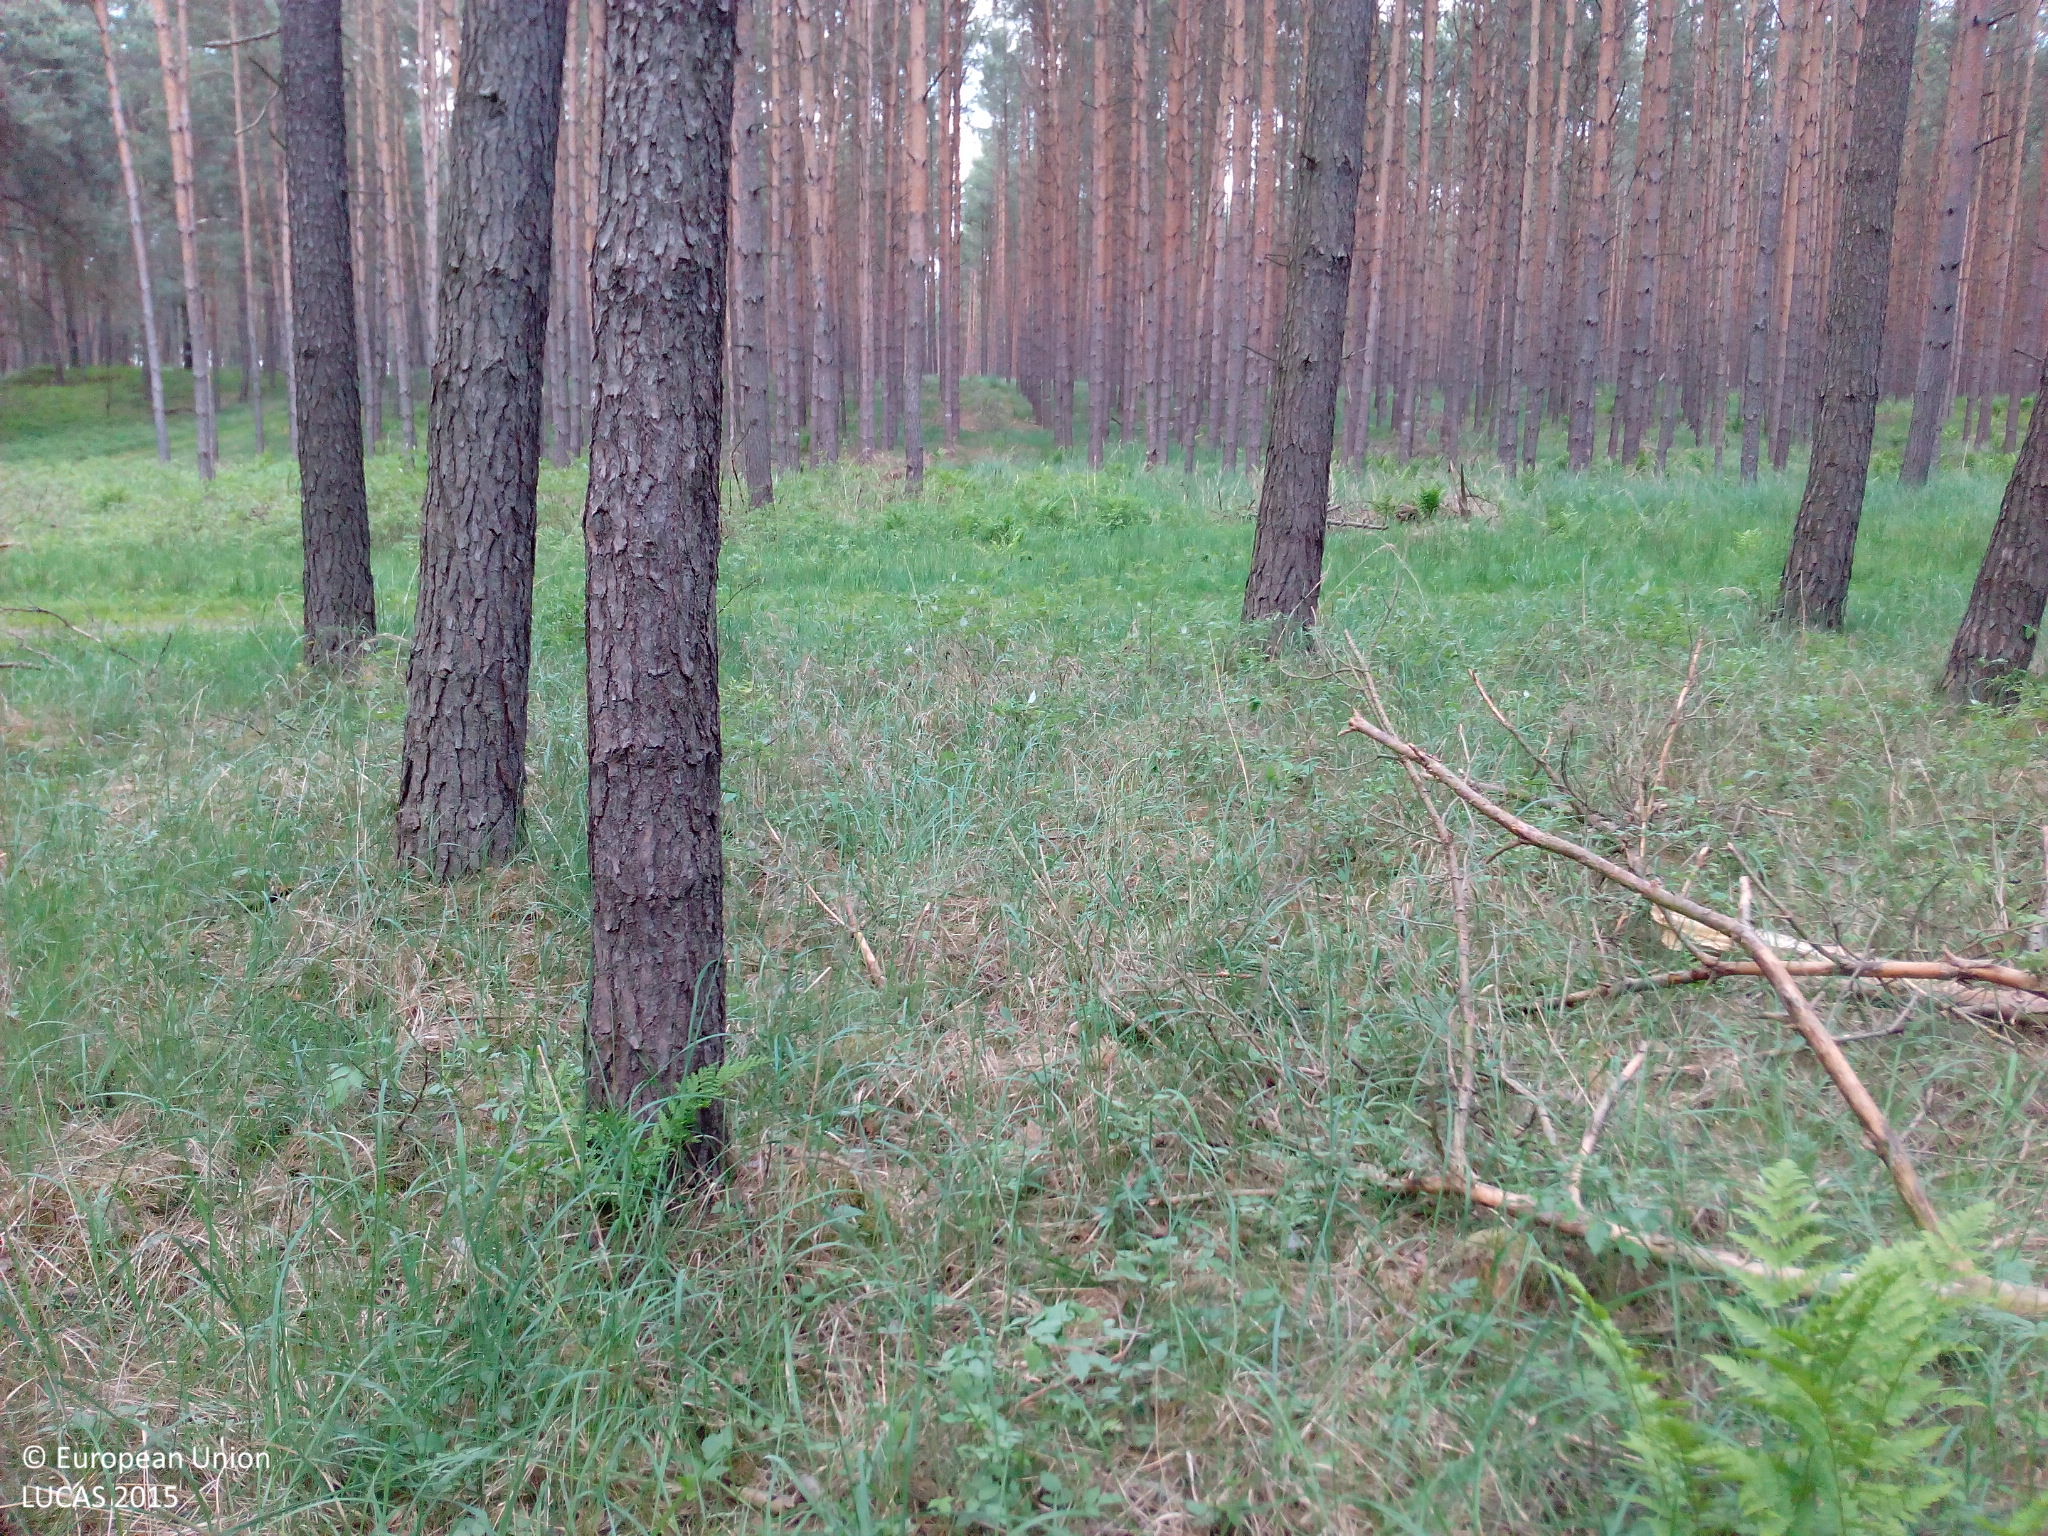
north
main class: Woodland
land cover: Pine dominated coniferous woodland
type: hemiboreal forest and nemoral coniferous forest and mixed broadleaved-coniferous forest
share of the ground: > 75 %
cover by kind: coniferous forest trees 90 %, shrubs 5 %, herbaceous plants 5 %
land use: Forestry
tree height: > 5 m
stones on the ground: < 10 %
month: May
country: DE
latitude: 52.0623
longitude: 12.5523
